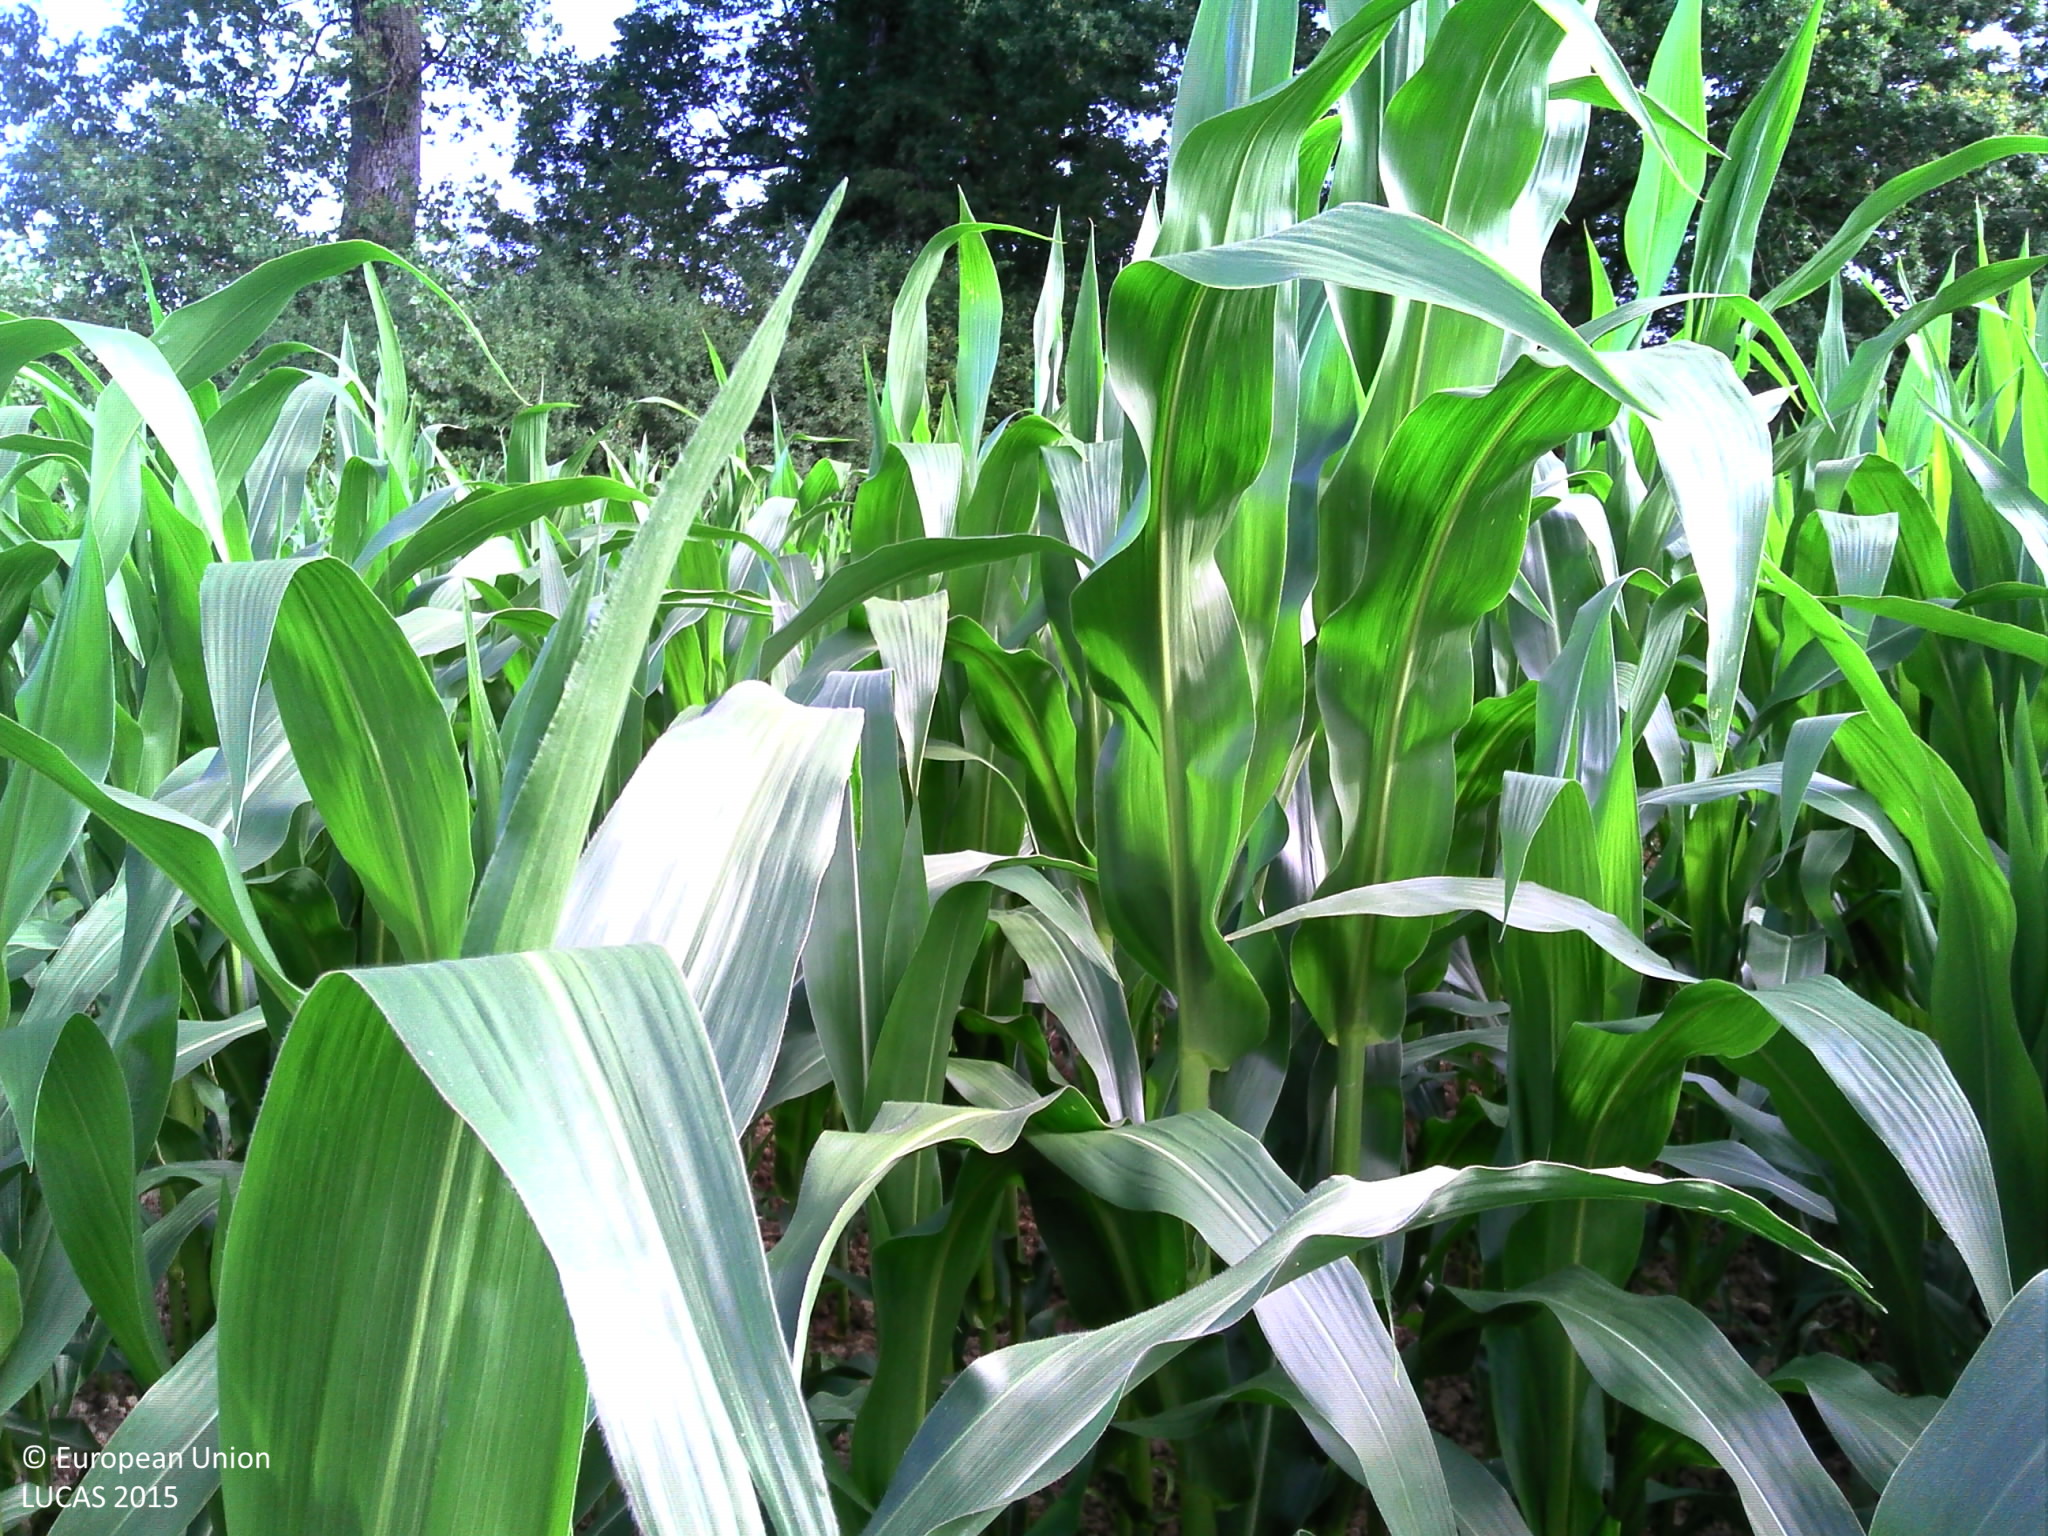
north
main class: Cropland
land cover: Maize
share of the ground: > 75 %
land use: Agriculture (excluding fallow land and kitchen gardens)
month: July
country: BE
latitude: 49.6853
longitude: 5.6048
